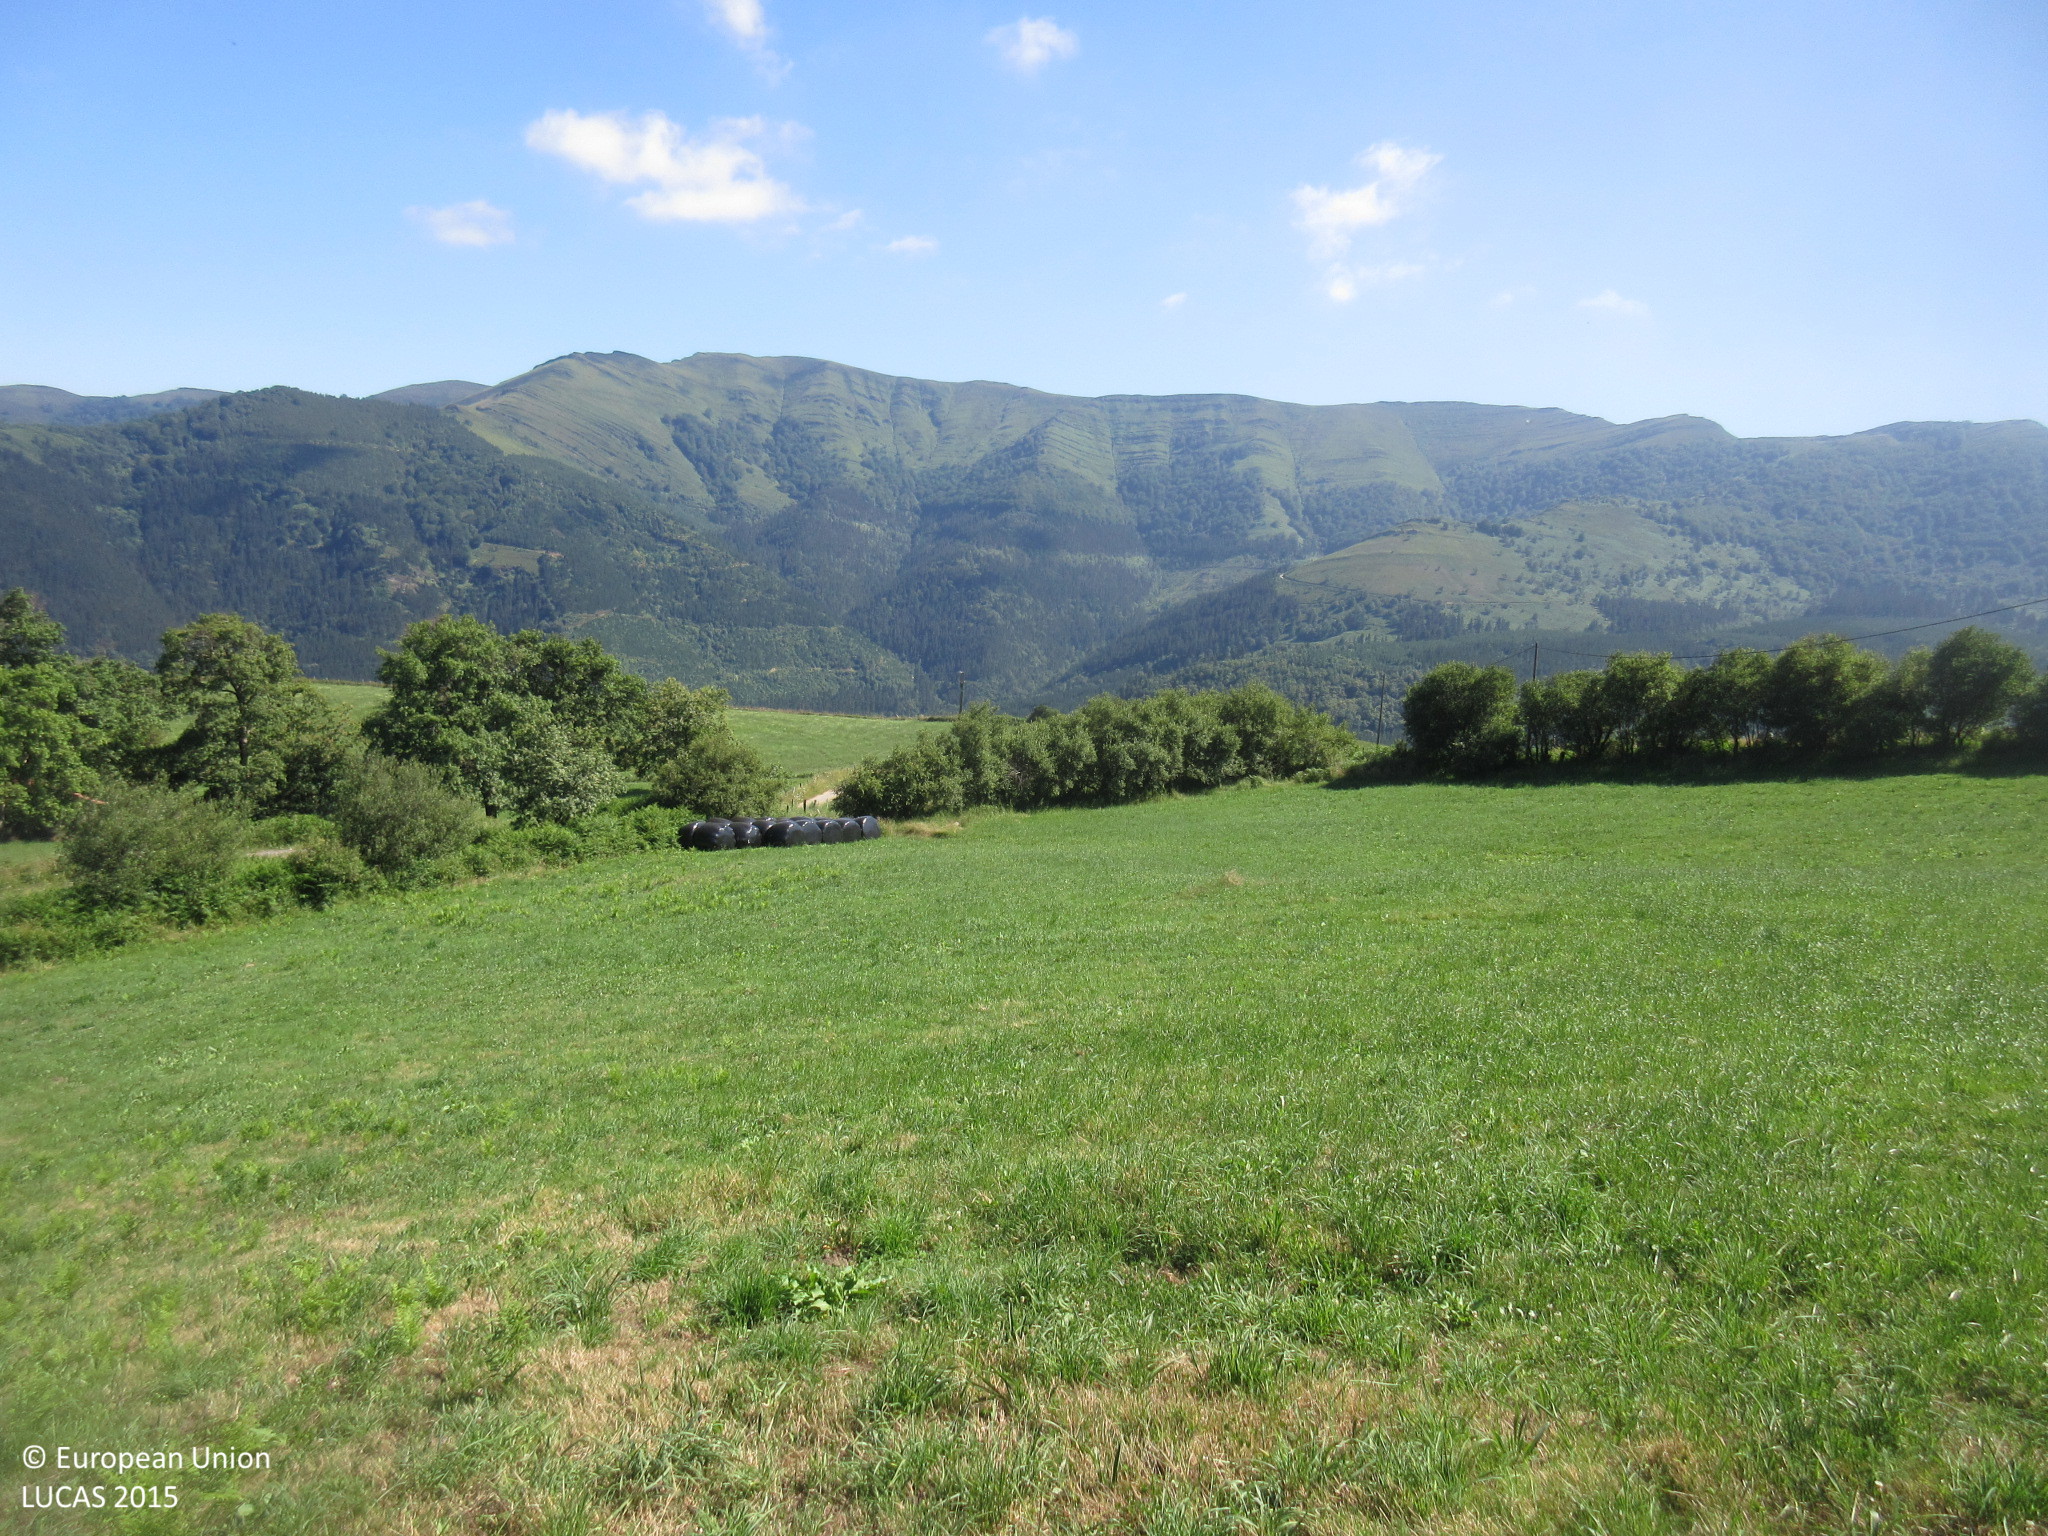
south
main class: Grassland
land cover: Grassland without tree/shrub cover
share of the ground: > 75 %
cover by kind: herbaceous plants 100 %
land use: Agriculture (excluding fallow land and kitchen gardens)
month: July
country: ES
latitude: 43.1860
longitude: -3.3898
